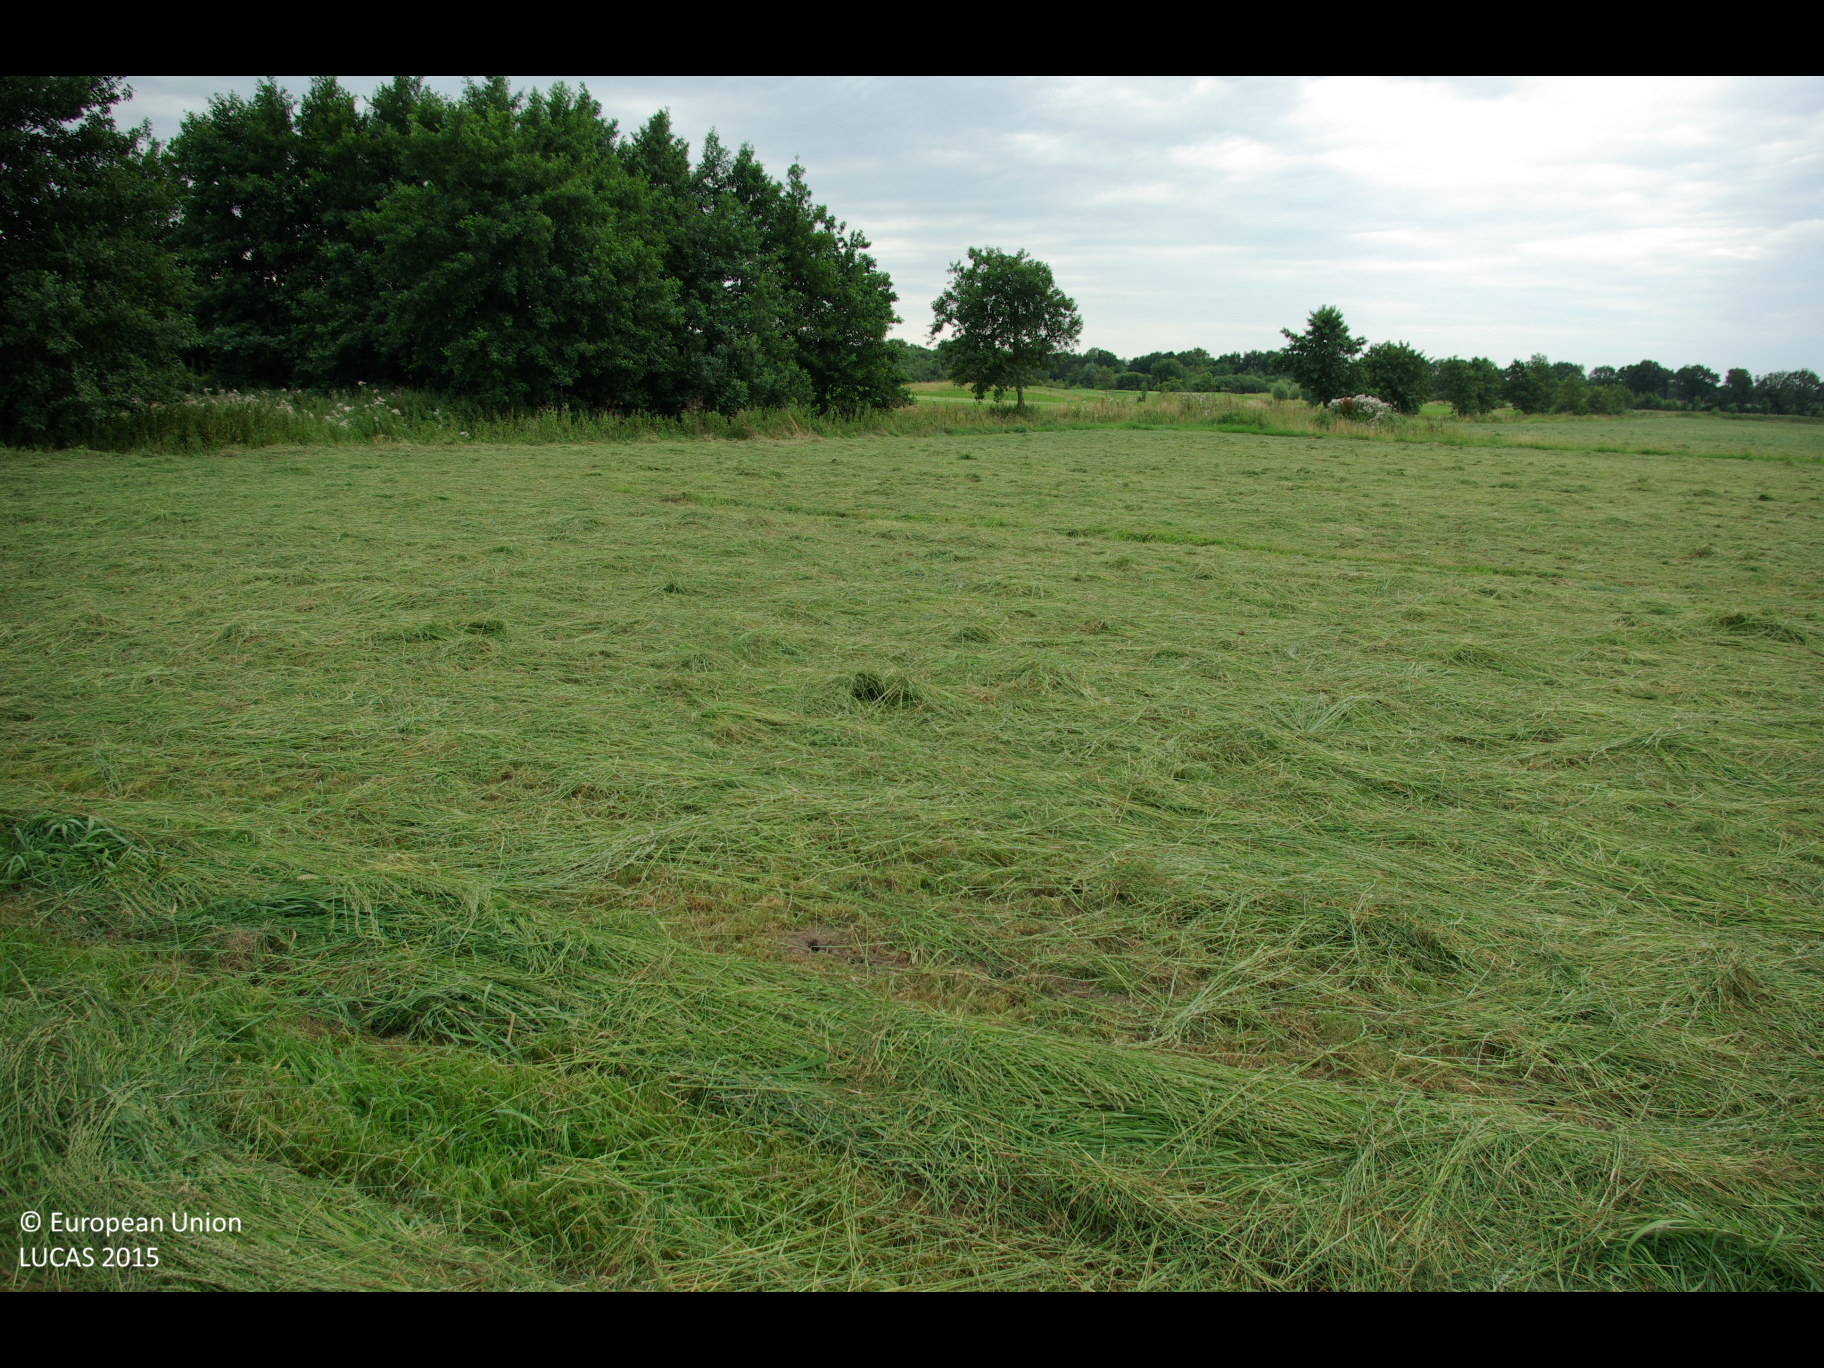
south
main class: Grassland
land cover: Grassland without tree/shrub cover
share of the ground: > 75 %
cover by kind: herbaceous plants 100 %
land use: Agriculture (excluding fallow land and kitchen gardens)
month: August
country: DE
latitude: 54.2799
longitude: 9.1865
